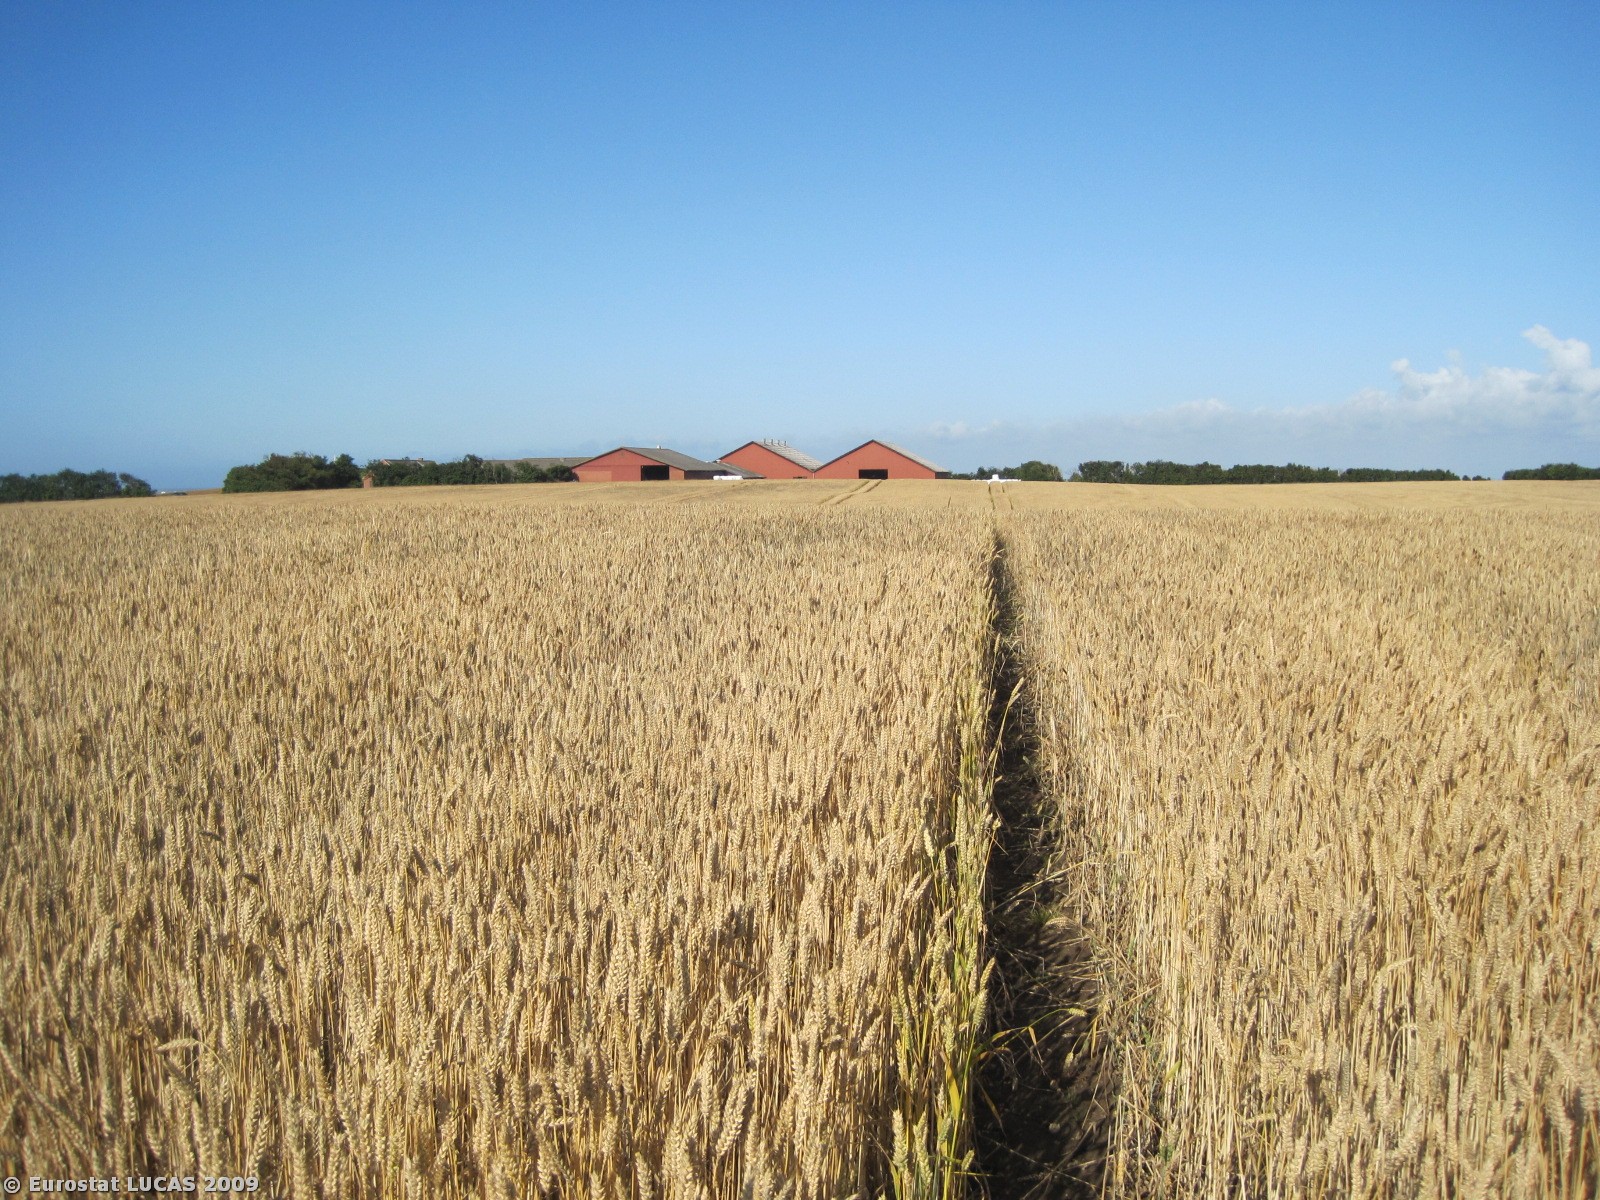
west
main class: Cropland
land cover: Common wheat
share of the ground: > 75 %
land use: Agriculture (excluding fallow land and kitchen gardens)
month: July
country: DK
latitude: 56.7341
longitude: 8.3185
